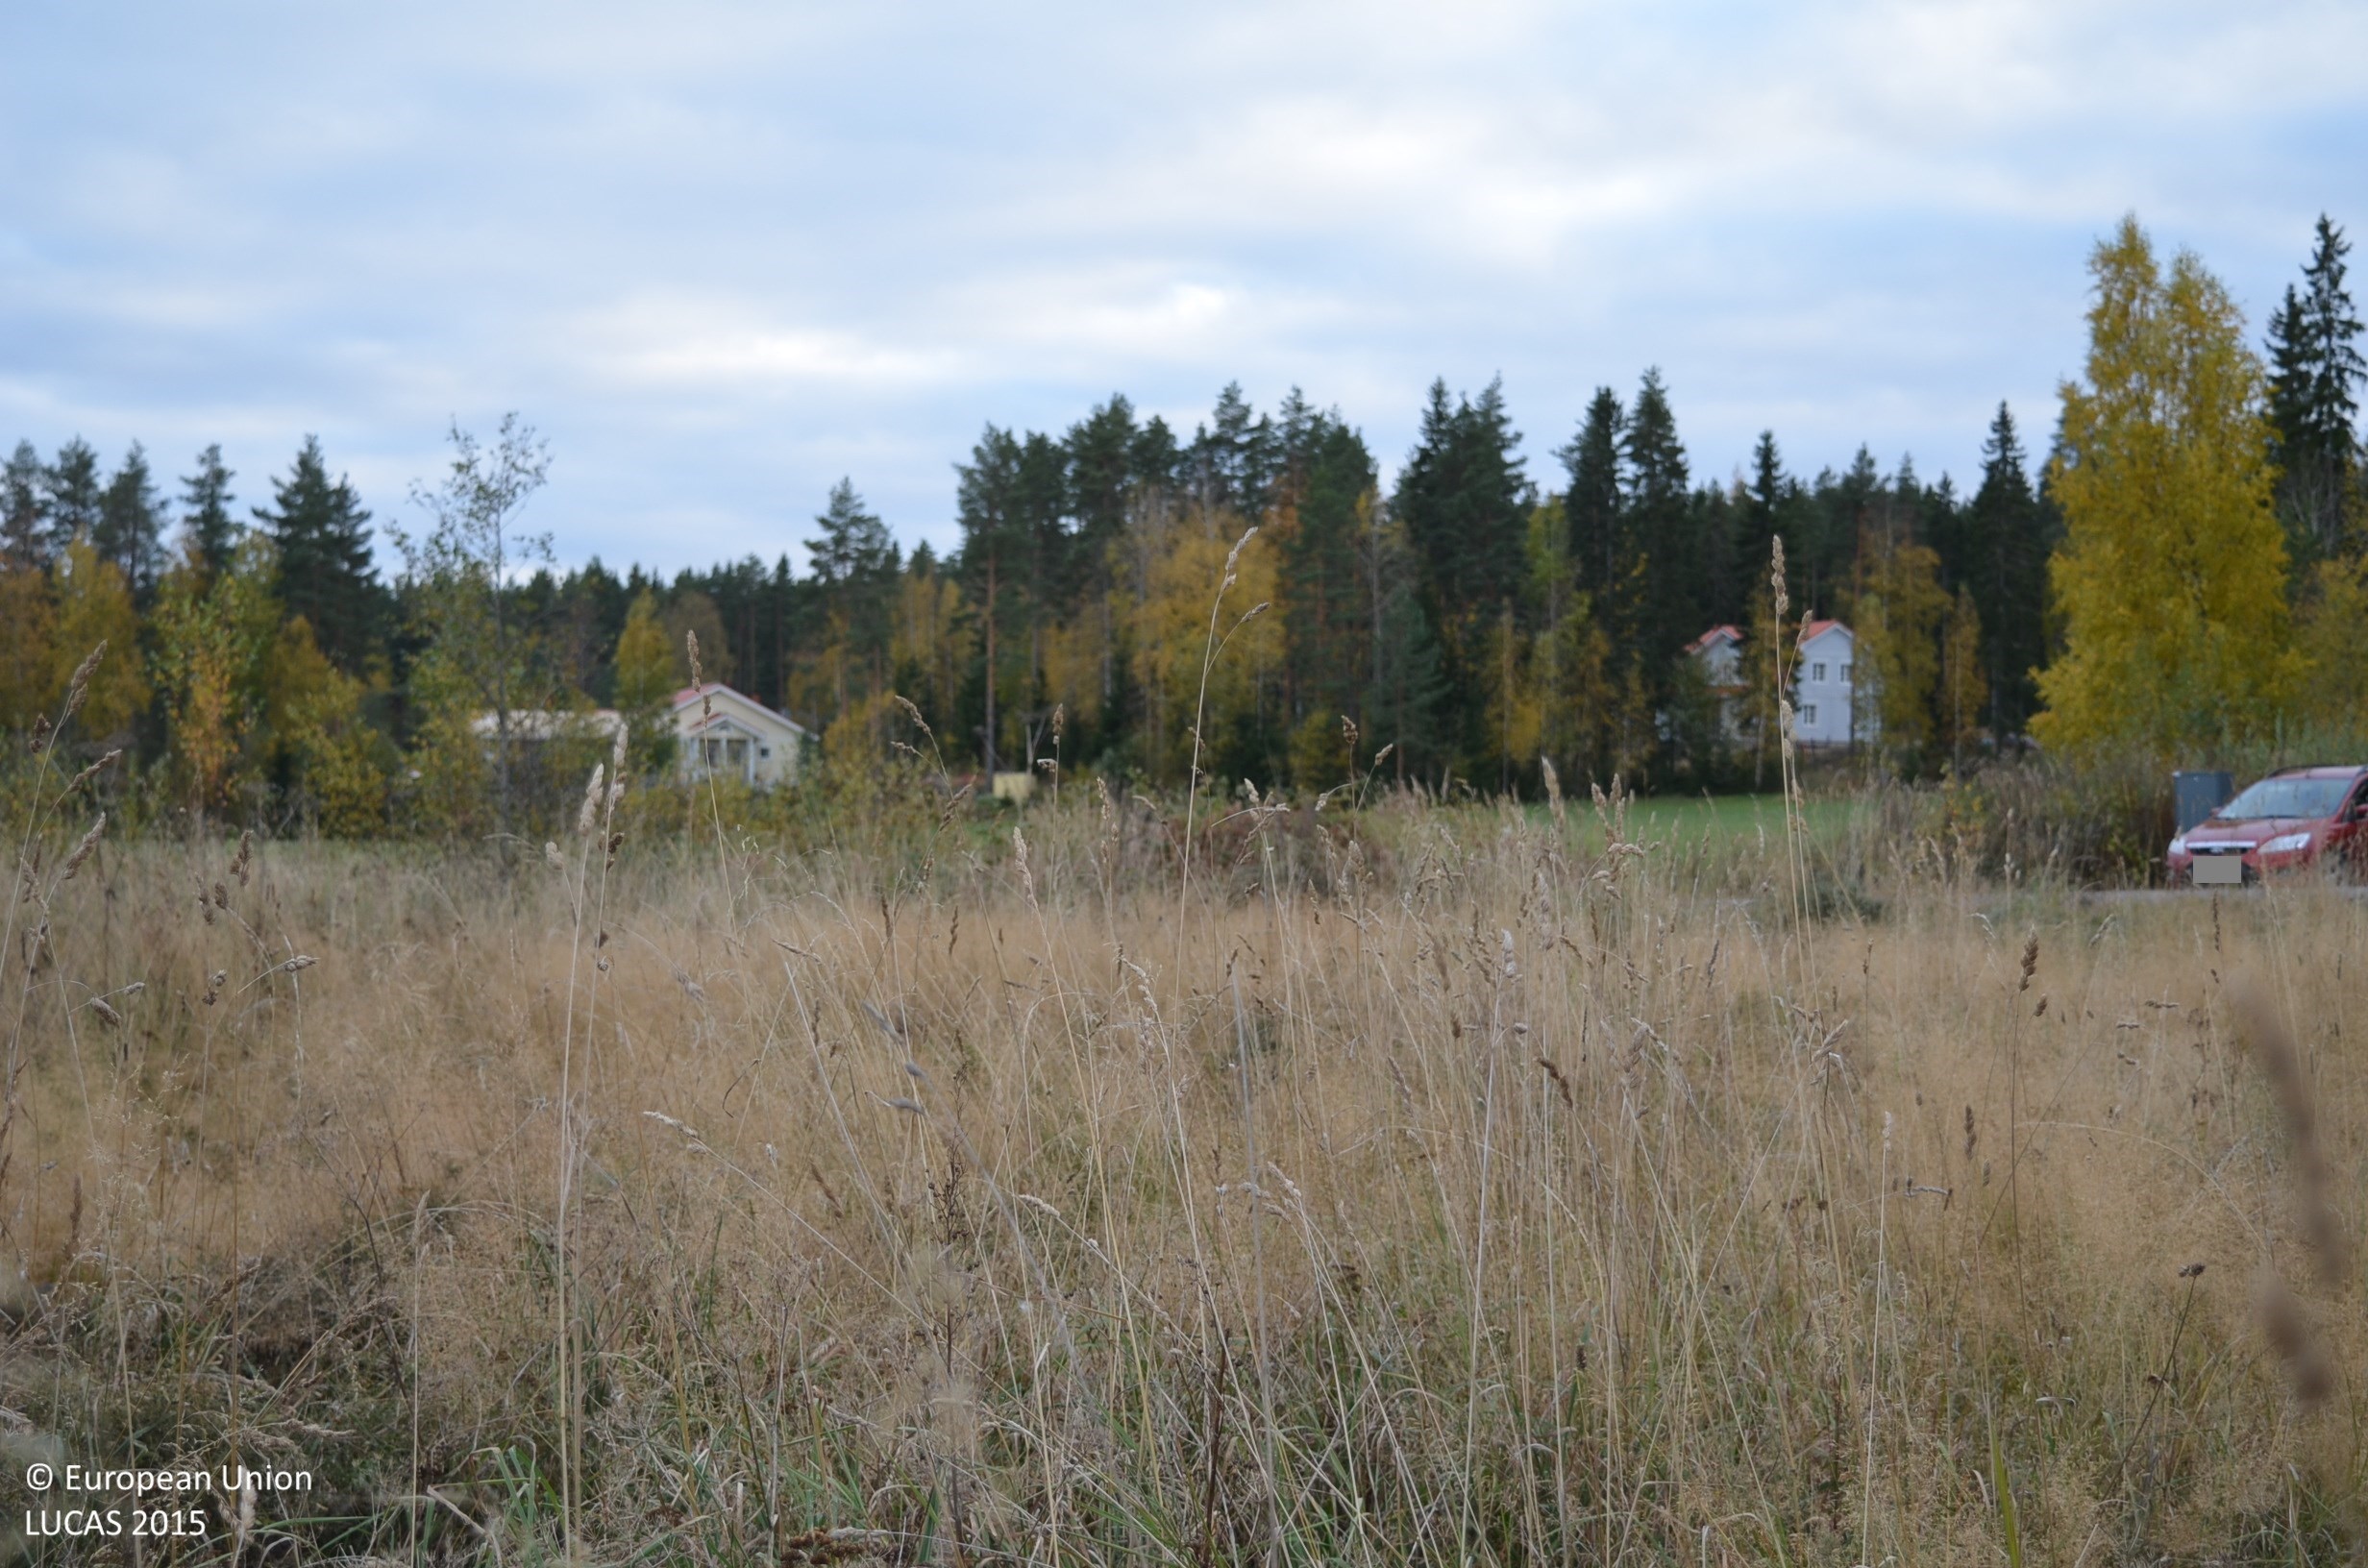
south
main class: Grassland
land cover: Grassland without tree/shrub cover
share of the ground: > 75 %
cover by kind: herbaceous plants 100 %
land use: Abandoned areas
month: October
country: FI
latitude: 61.6245
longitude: 23.7965
